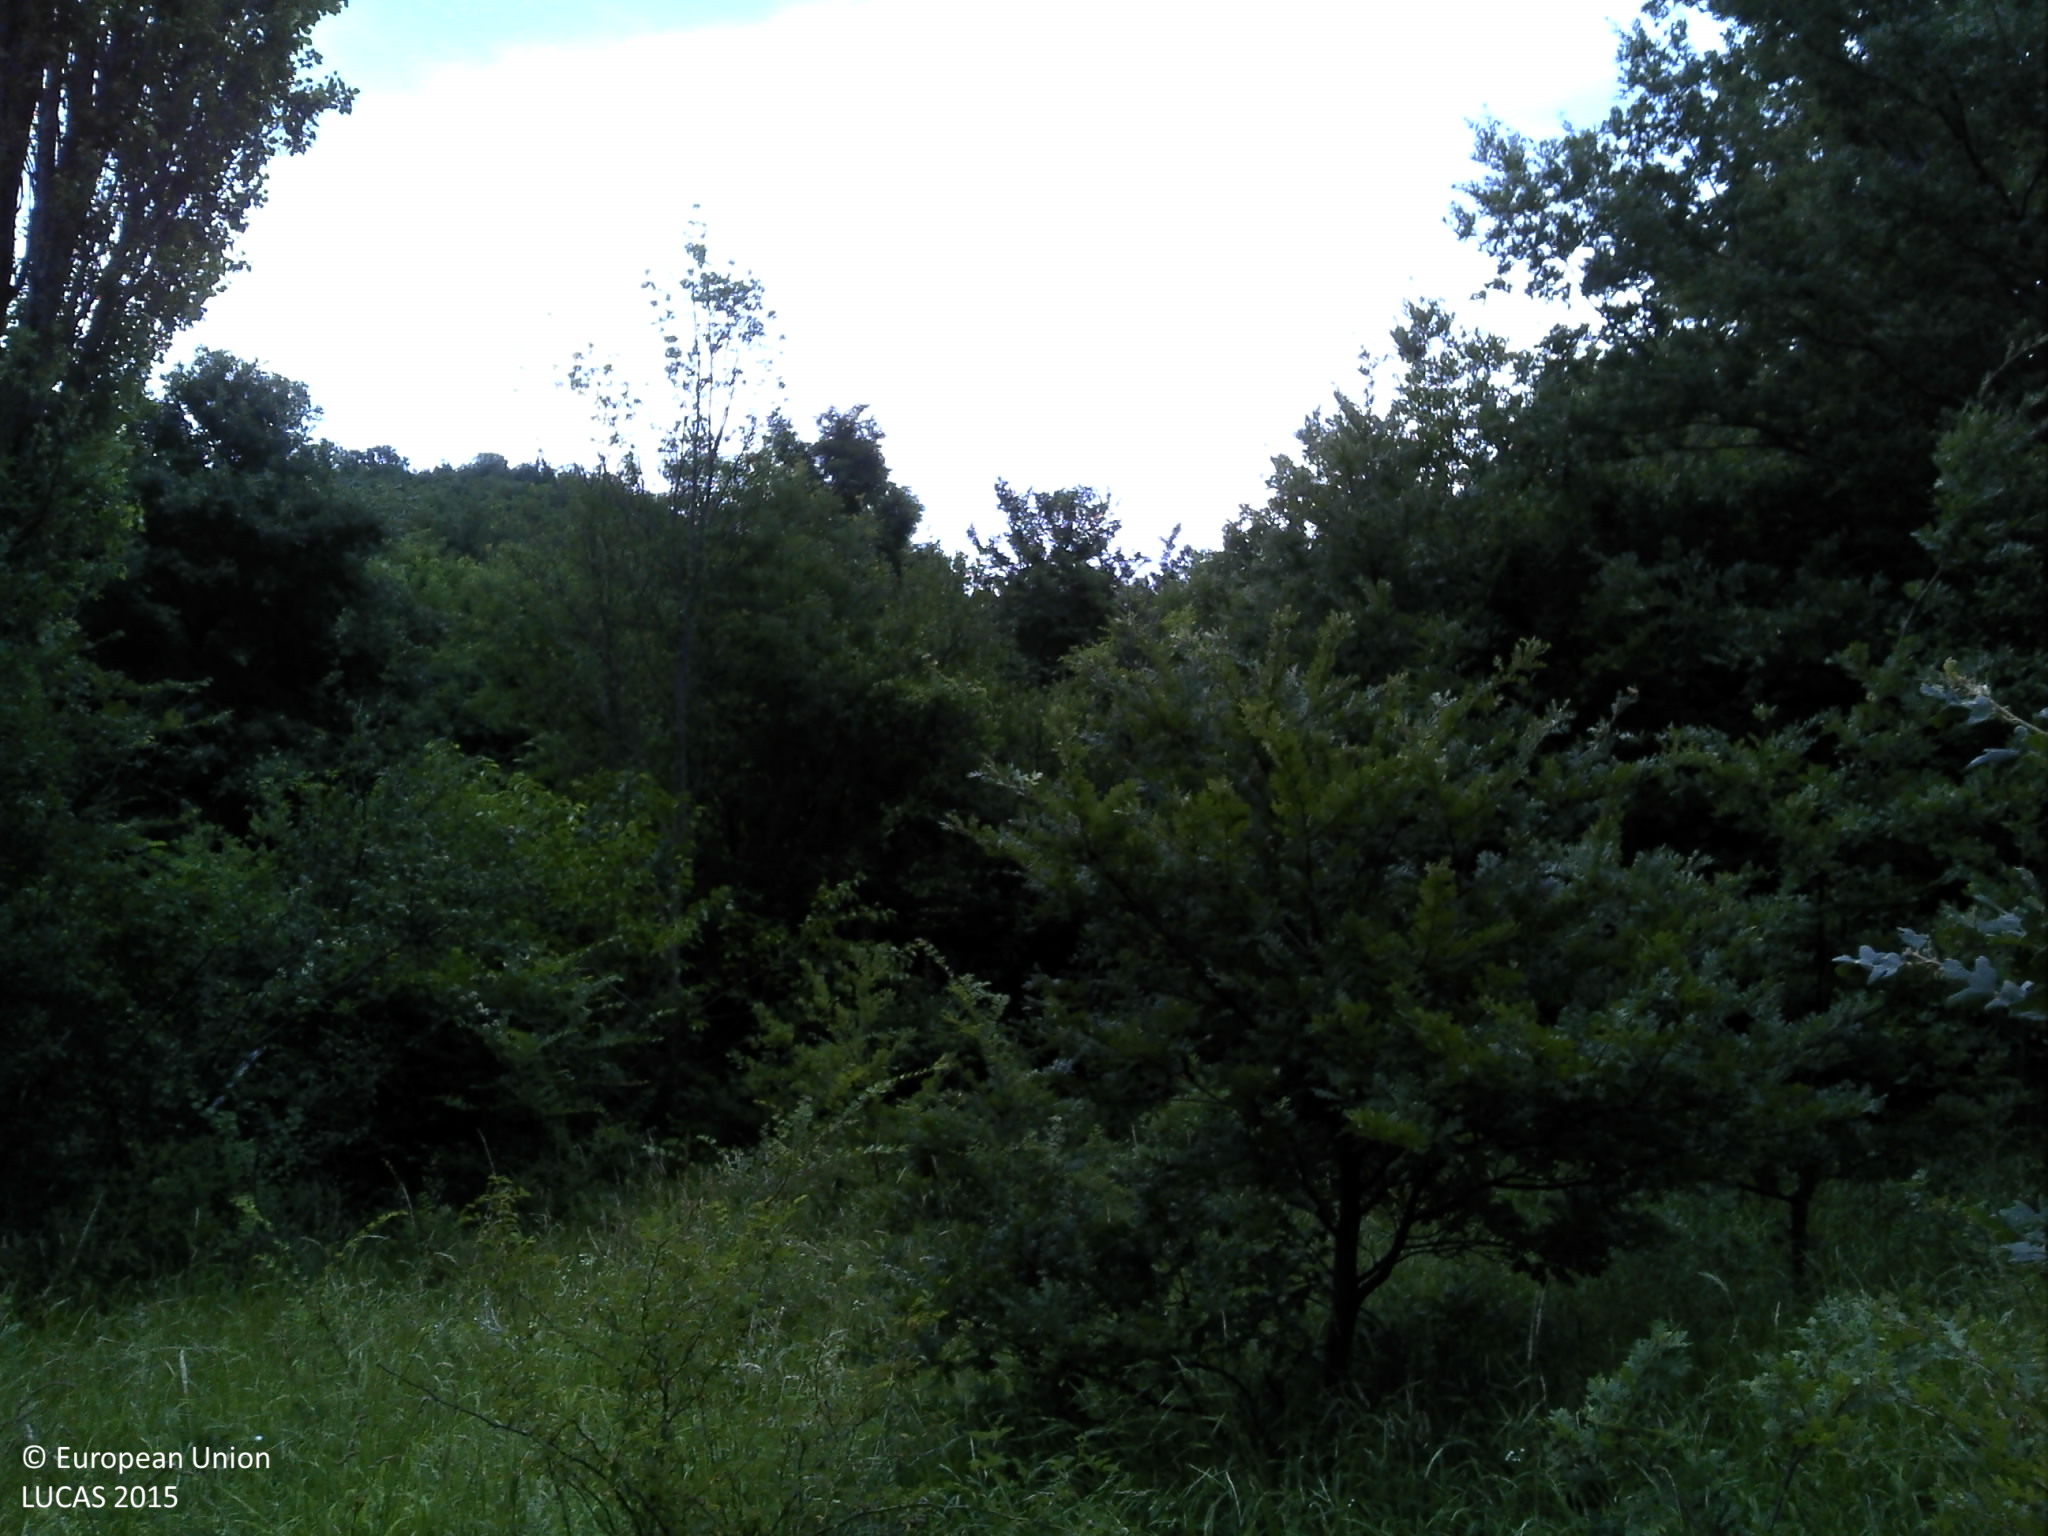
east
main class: Woodland
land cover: Broadleaved woodland
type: mesophytic deciduous forest
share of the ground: 25 - 50 %
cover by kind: broadleaved forest trees 40 %, shrubs 30 %, herbaceous plants 30 %
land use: Semi-natural and natural areas not in use
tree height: > 5 m
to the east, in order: Broadleaved woodland; Grassland with sparse tree/shrub cover; Broadleaved woodland
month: June
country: HR
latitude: 44.1915
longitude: 16.0608
